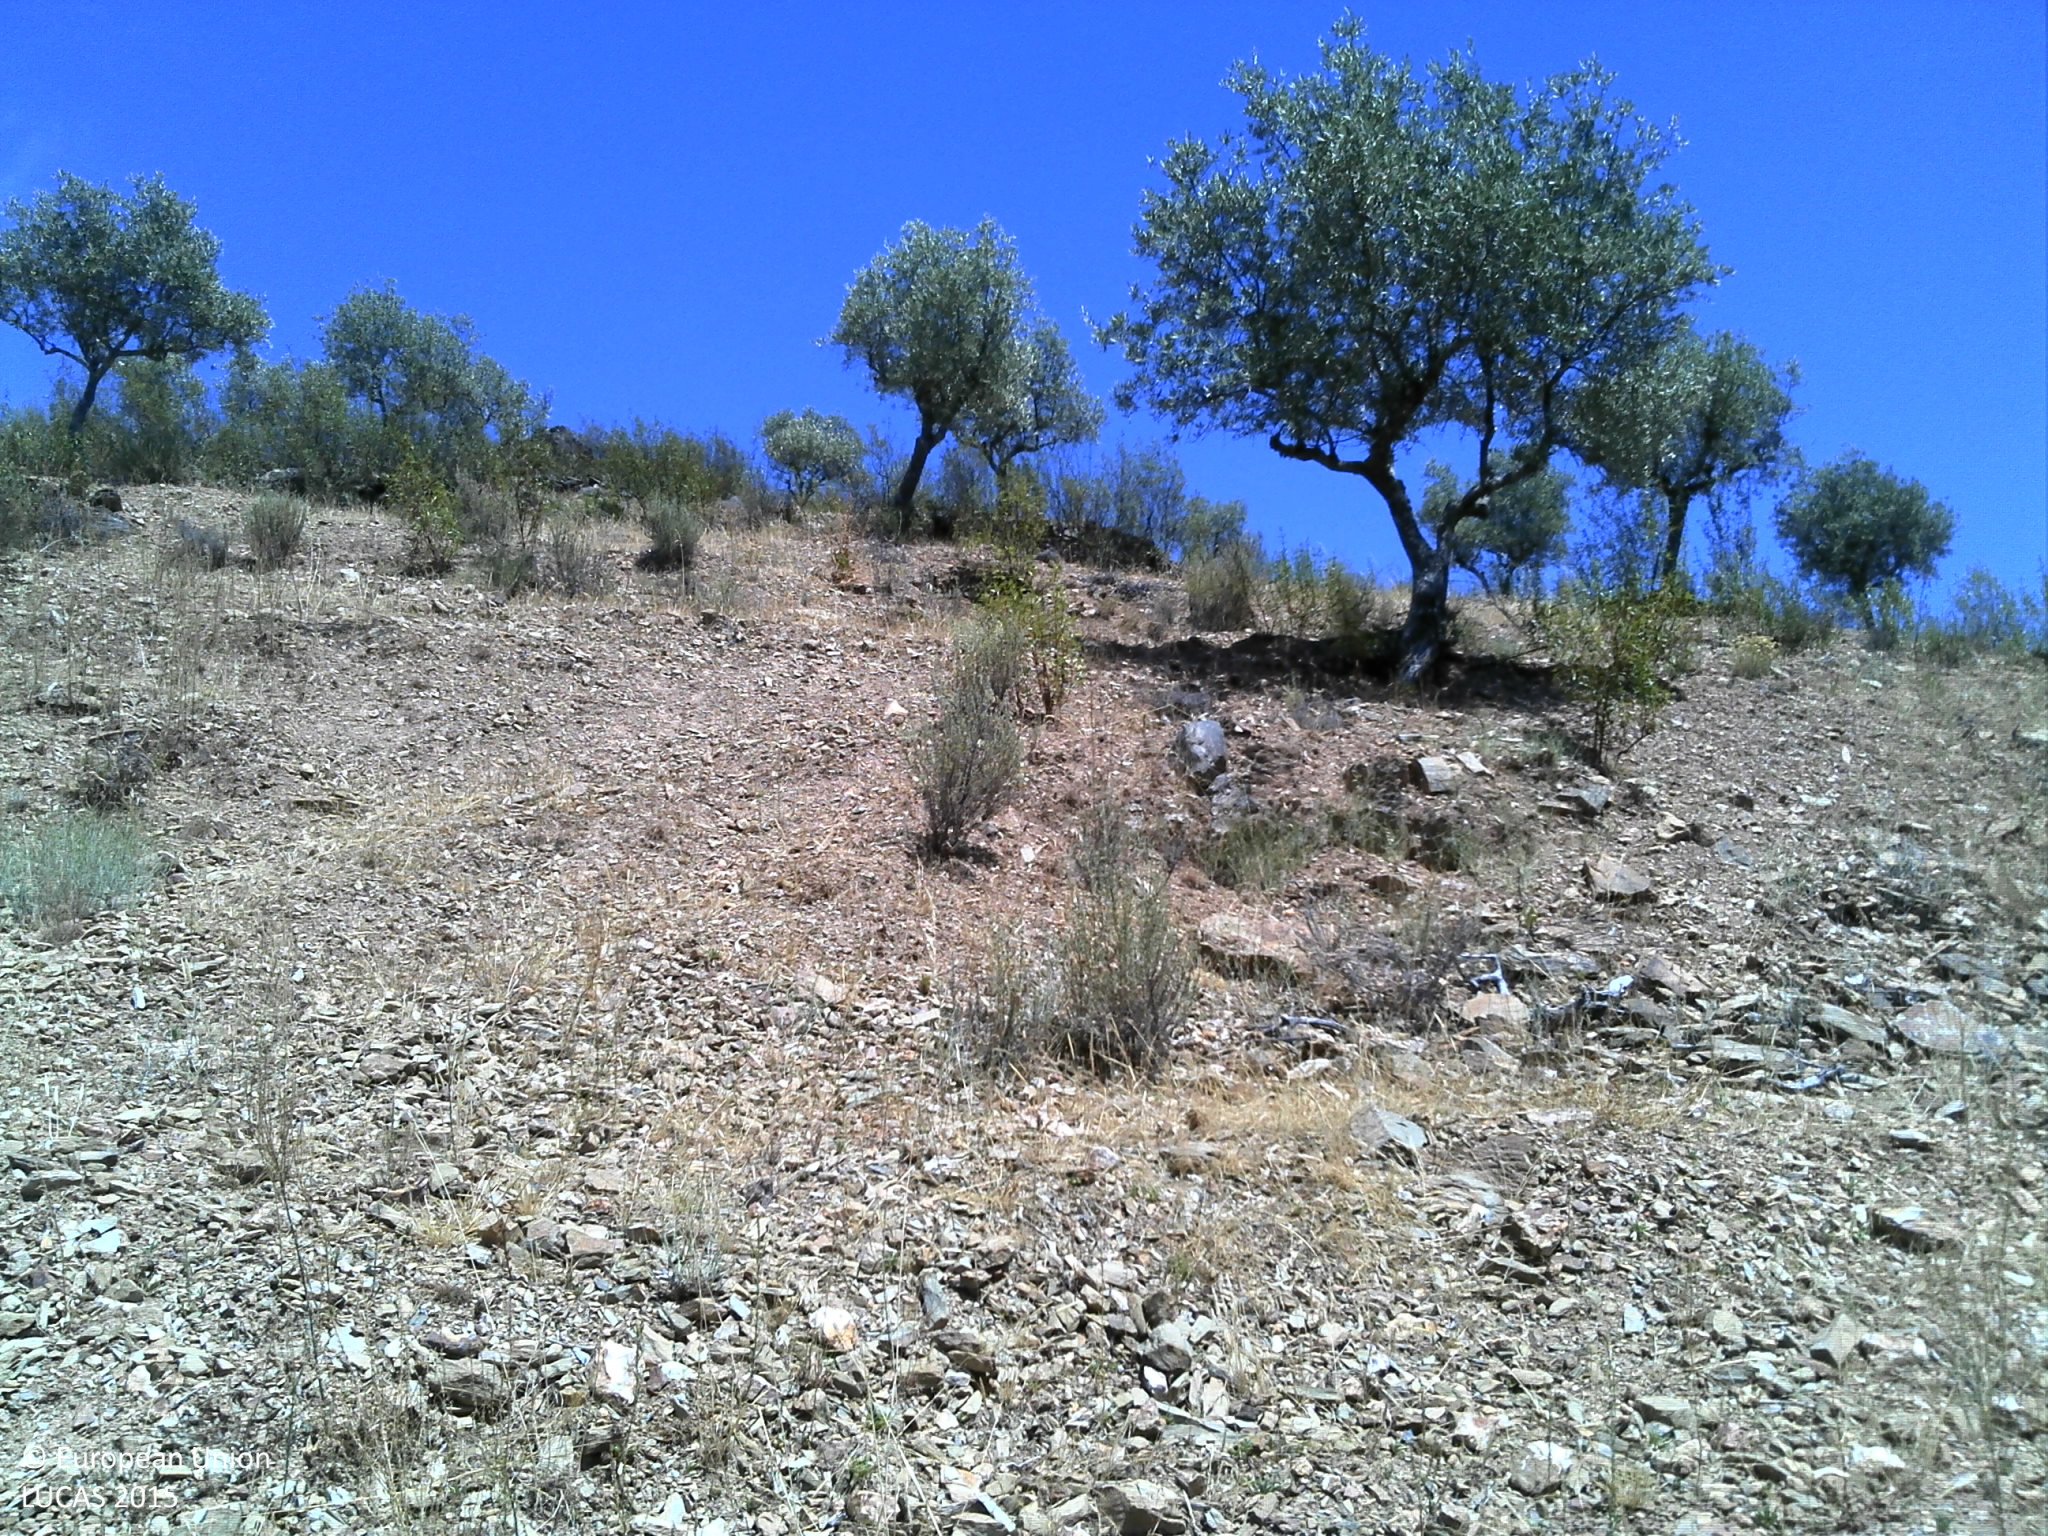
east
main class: Cropland
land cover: Olive groves
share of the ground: 10 - 25 %
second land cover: Shrubland without tree cover
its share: 10 - 25 %
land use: Agriculture (excluding fallow land and kitchen gardens)
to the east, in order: Olive groves; Shrubland without tree cover; Olive groves; Dry stone walls; Olive groves; Dry stone walls; Olive groves; Shrubland without tree cover; Fences; Tracks; Broadleaved woodland; Tracks; Shrubland without tree cover
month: July
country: PT
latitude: 39.6486
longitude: -7.7579
